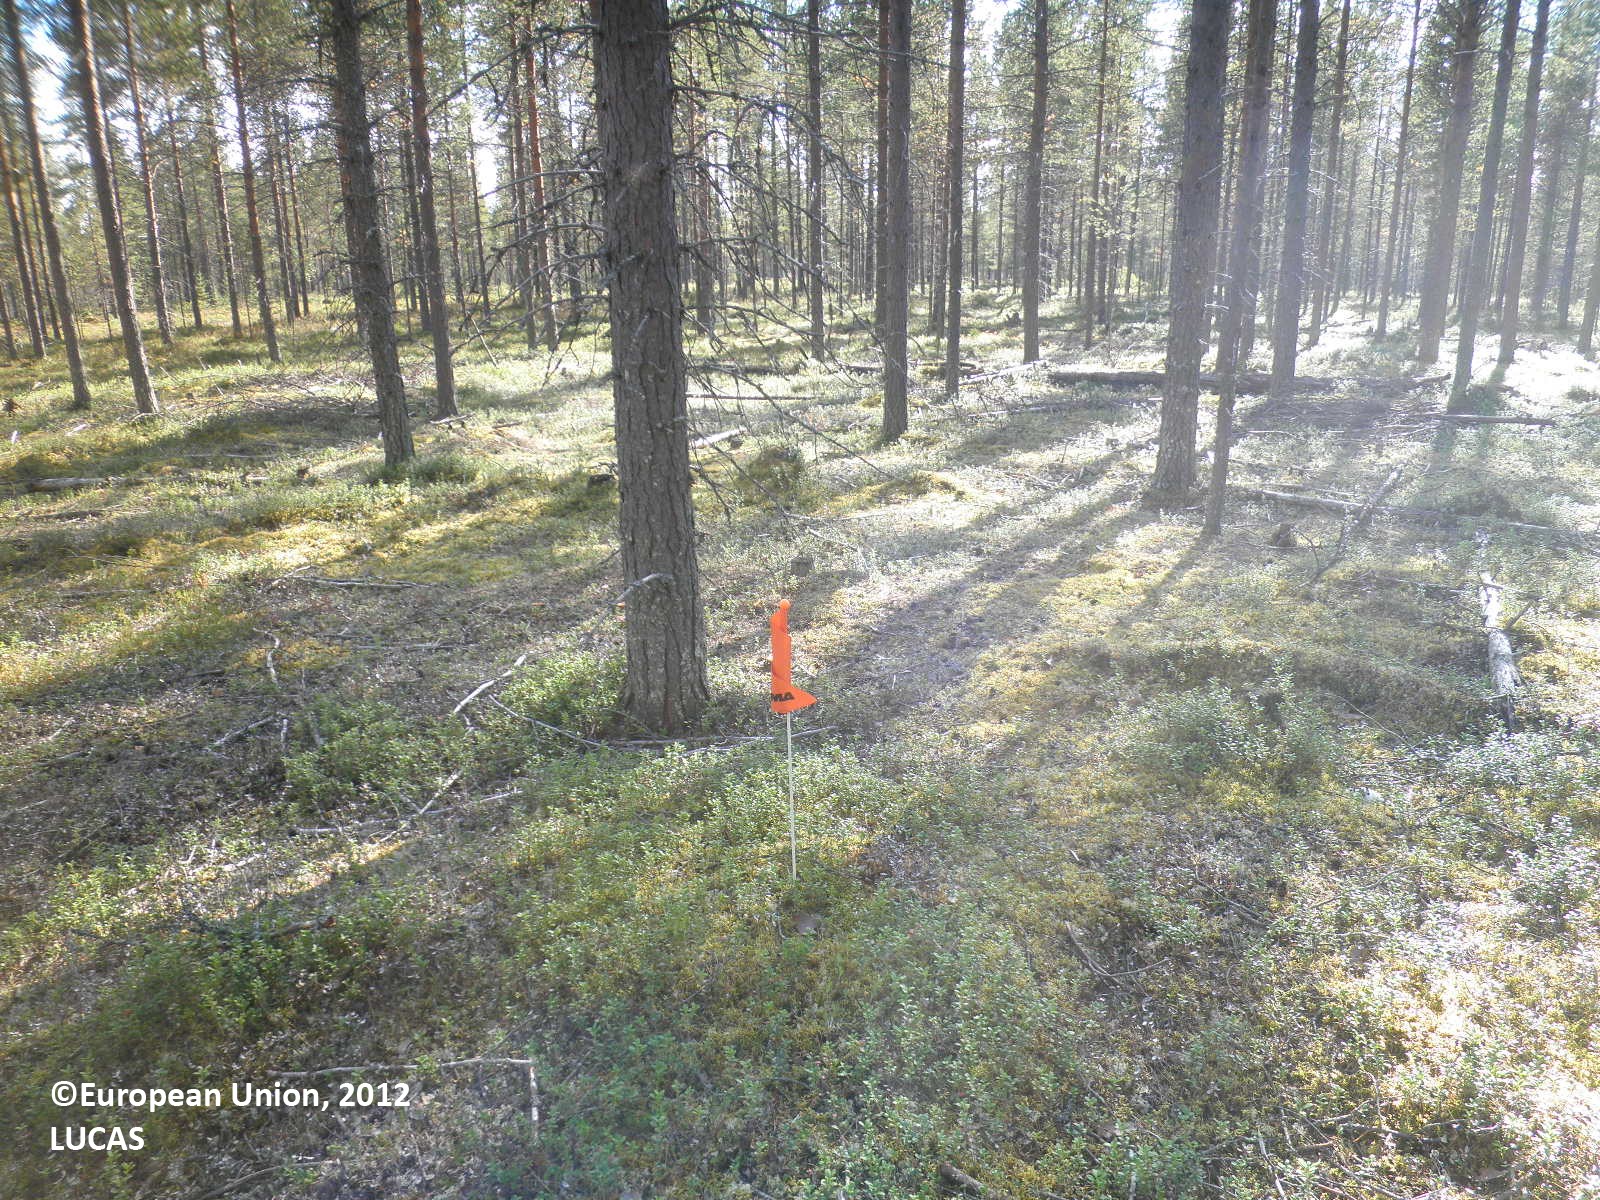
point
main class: Woodland
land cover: Pine dominated coniferous woodland
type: boreal forest
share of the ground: 50 - 75 %
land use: Forestry
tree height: > 5 m
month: August
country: FI
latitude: 67.6212
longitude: 28.6547
